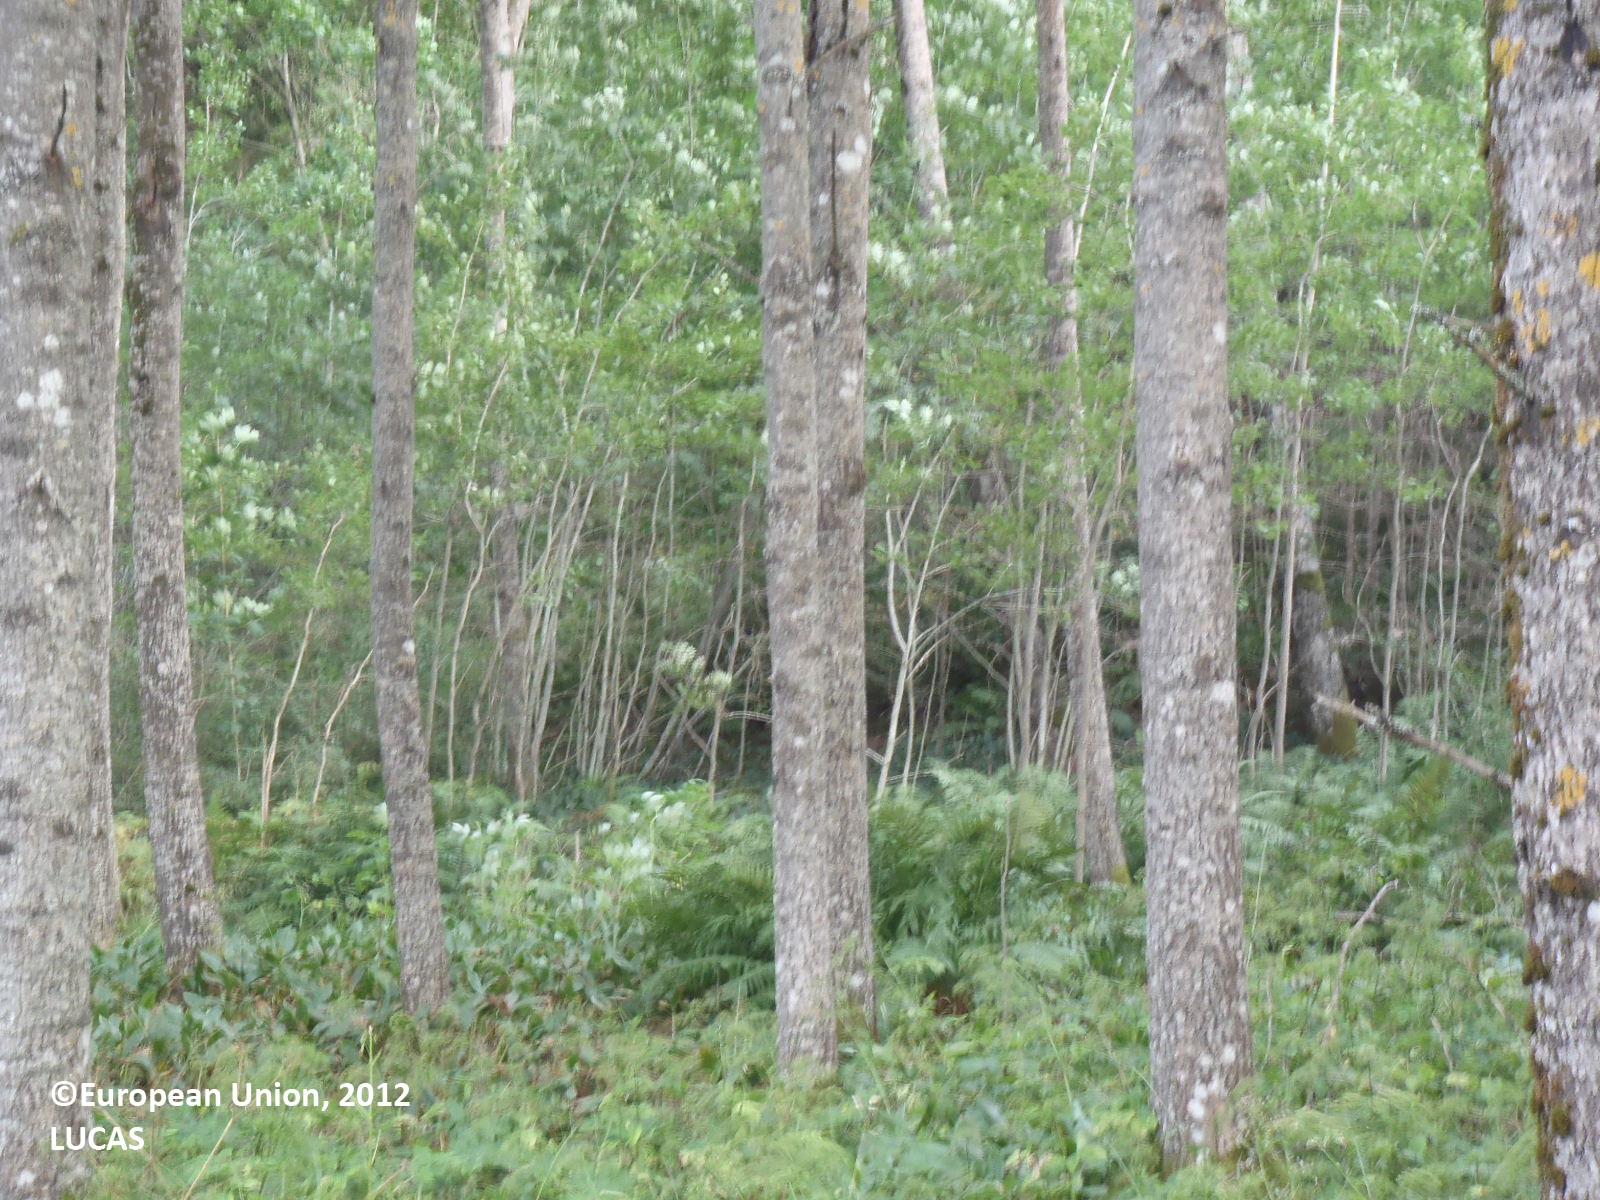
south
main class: Woodland
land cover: Broadleaved woodland
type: hemiboreal forest and nemoral coniferous forest and mixed broadleaved-coniferous forest
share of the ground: > 75 %
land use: Semi-natural and natural areas not in use
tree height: > 5 m
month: August
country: FI
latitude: 60.2809
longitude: 19.9702
